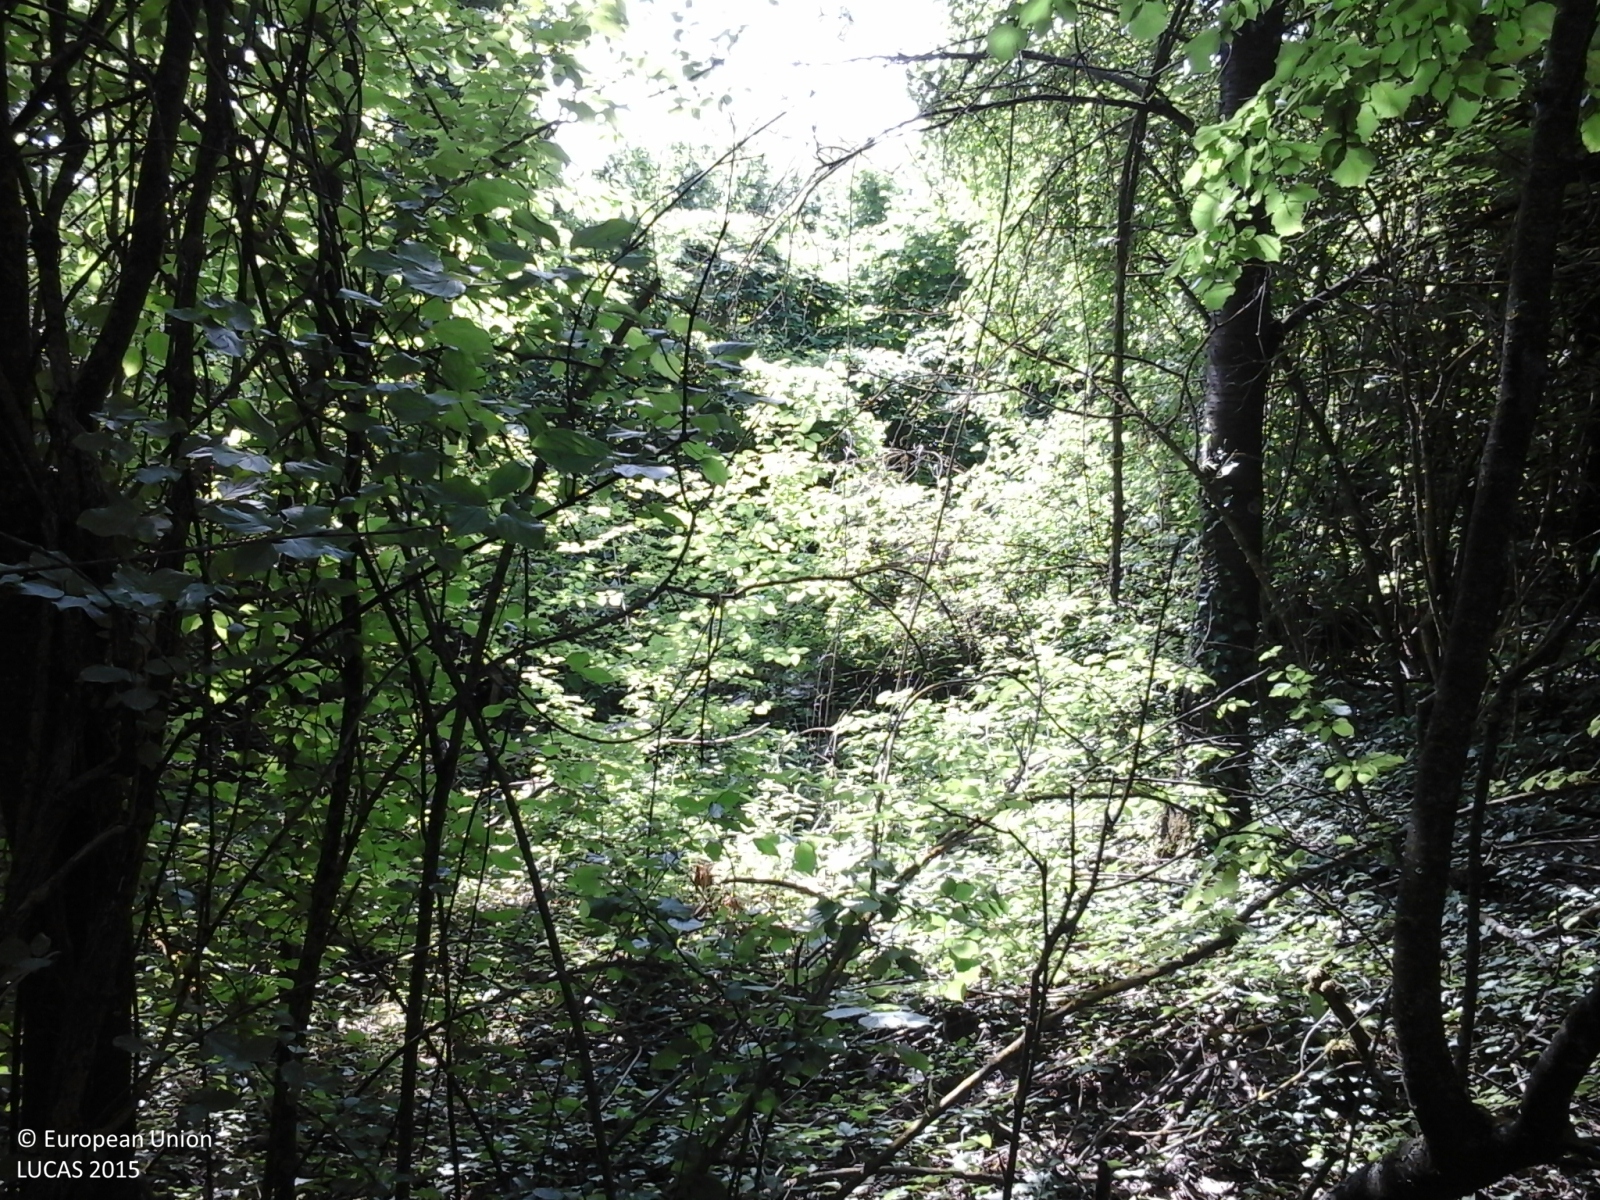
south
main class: Woodland
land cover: Broadleaved woodland
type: thermophilous deciduous forest
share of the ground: > 75 %
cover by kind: broadleaved forest trees 95 %, shrubs 5 %
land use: Forestry
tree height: > 5 m
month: May
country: IT
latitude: 44.7343
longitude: 8.3491
